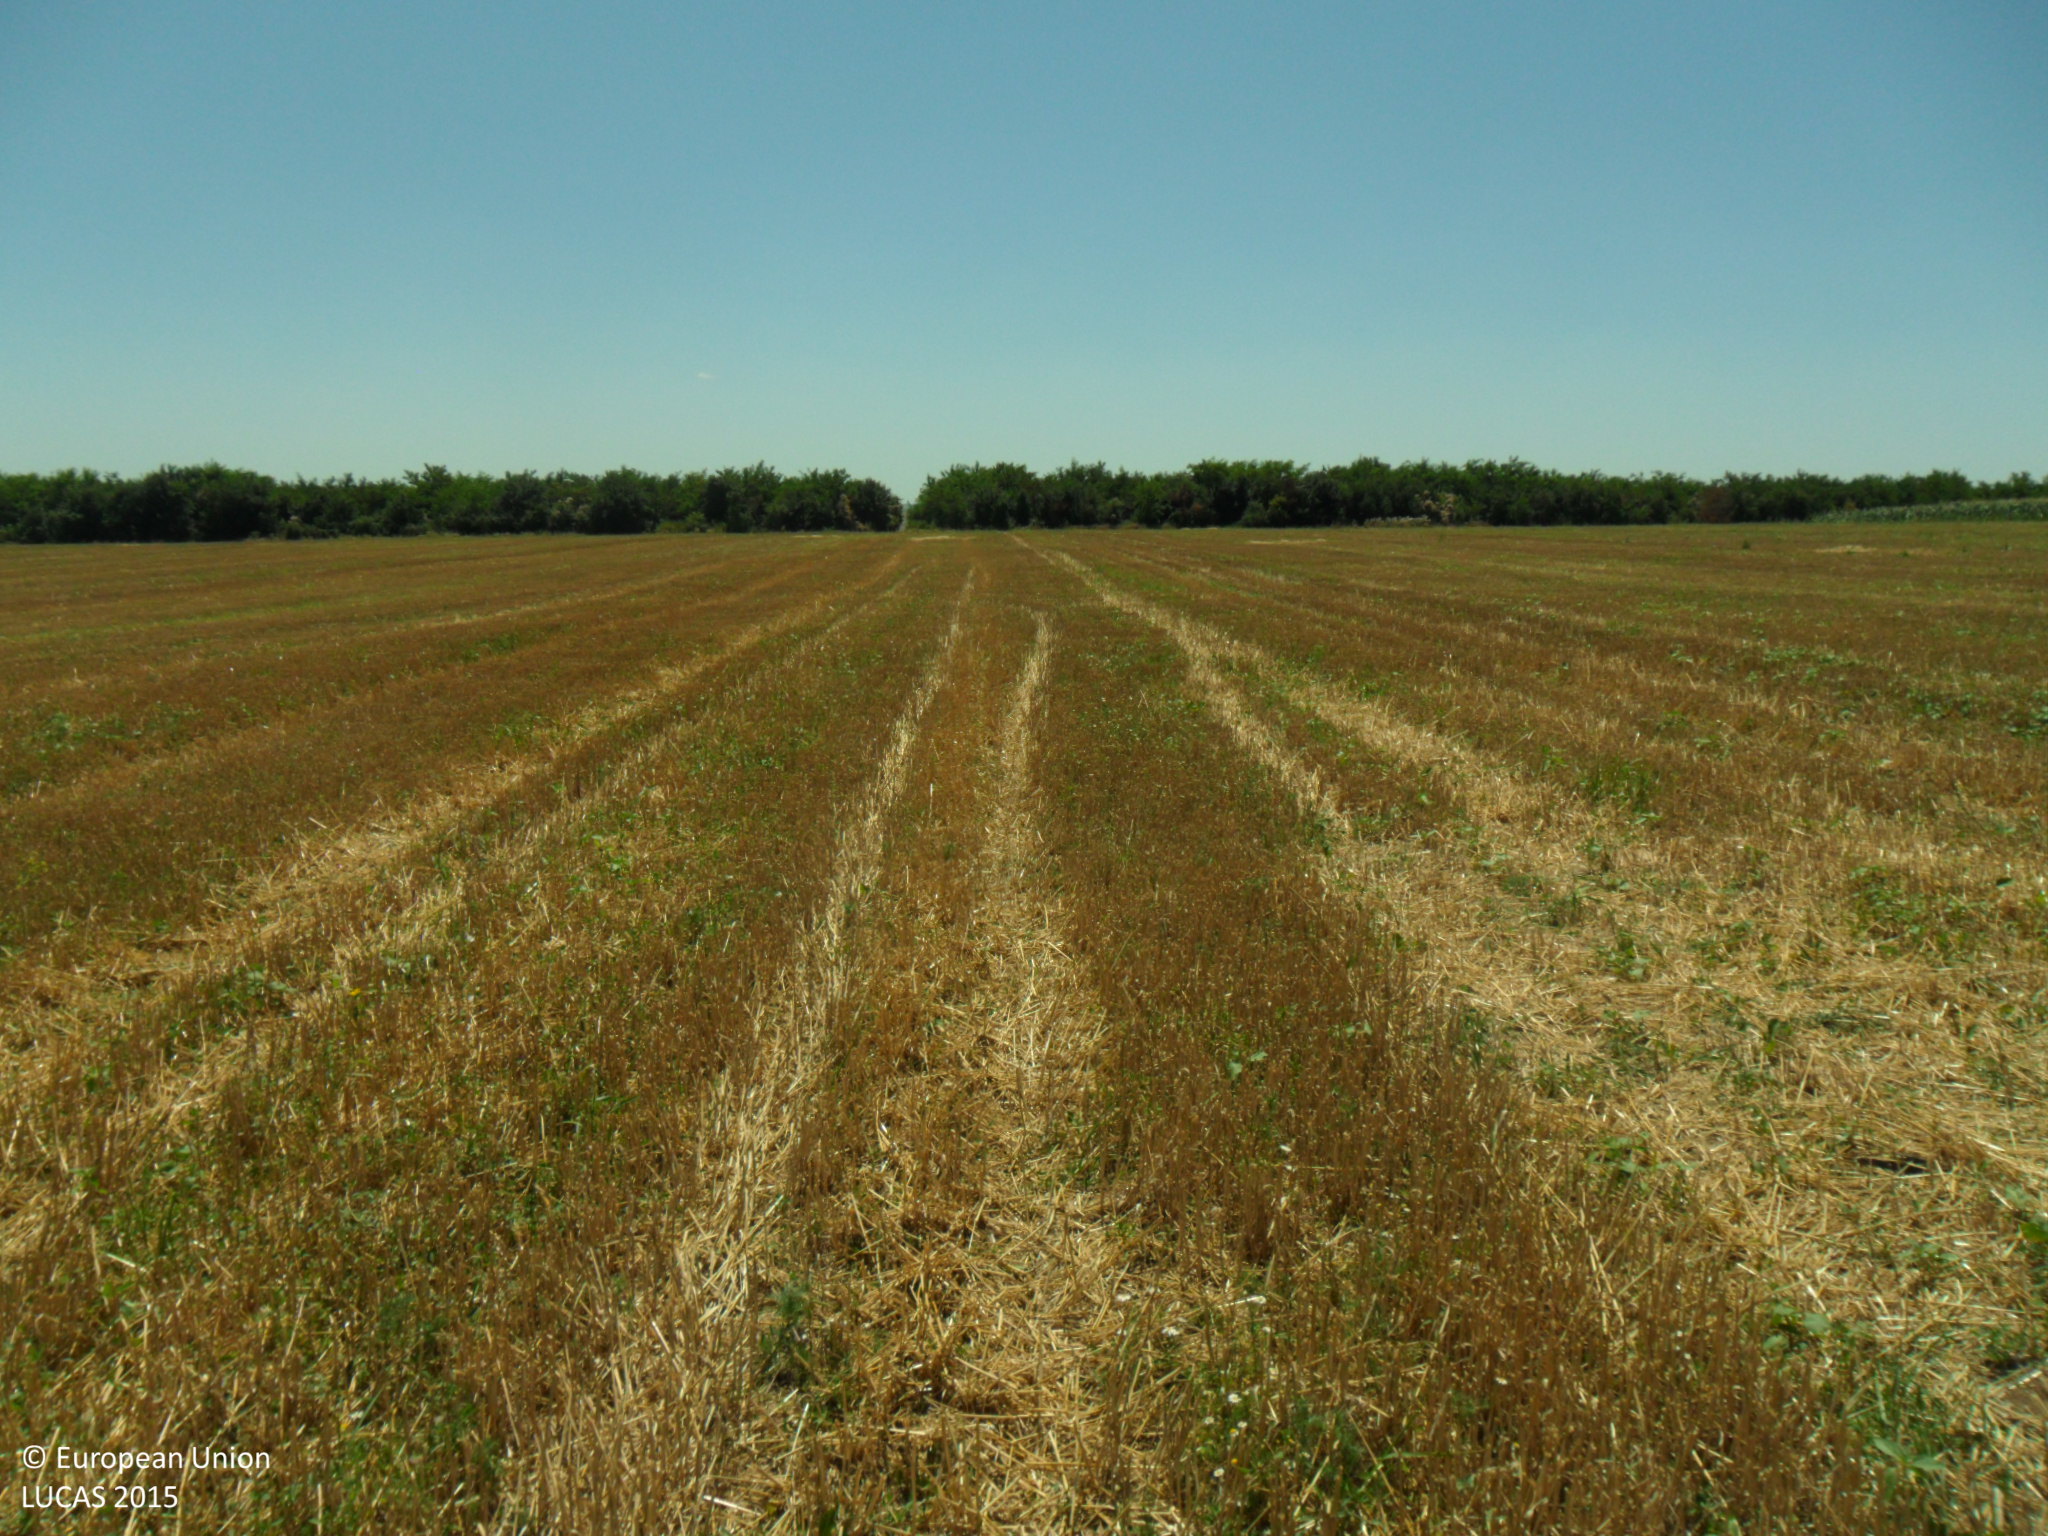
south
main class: Cropland
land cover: Common wheat
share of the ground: 50 - 75 %
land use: Agriculture (excluding fallow land and kitchen gardens)
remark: Harvested field
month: July
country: BG
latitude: 43.8025
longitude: 26.4265
